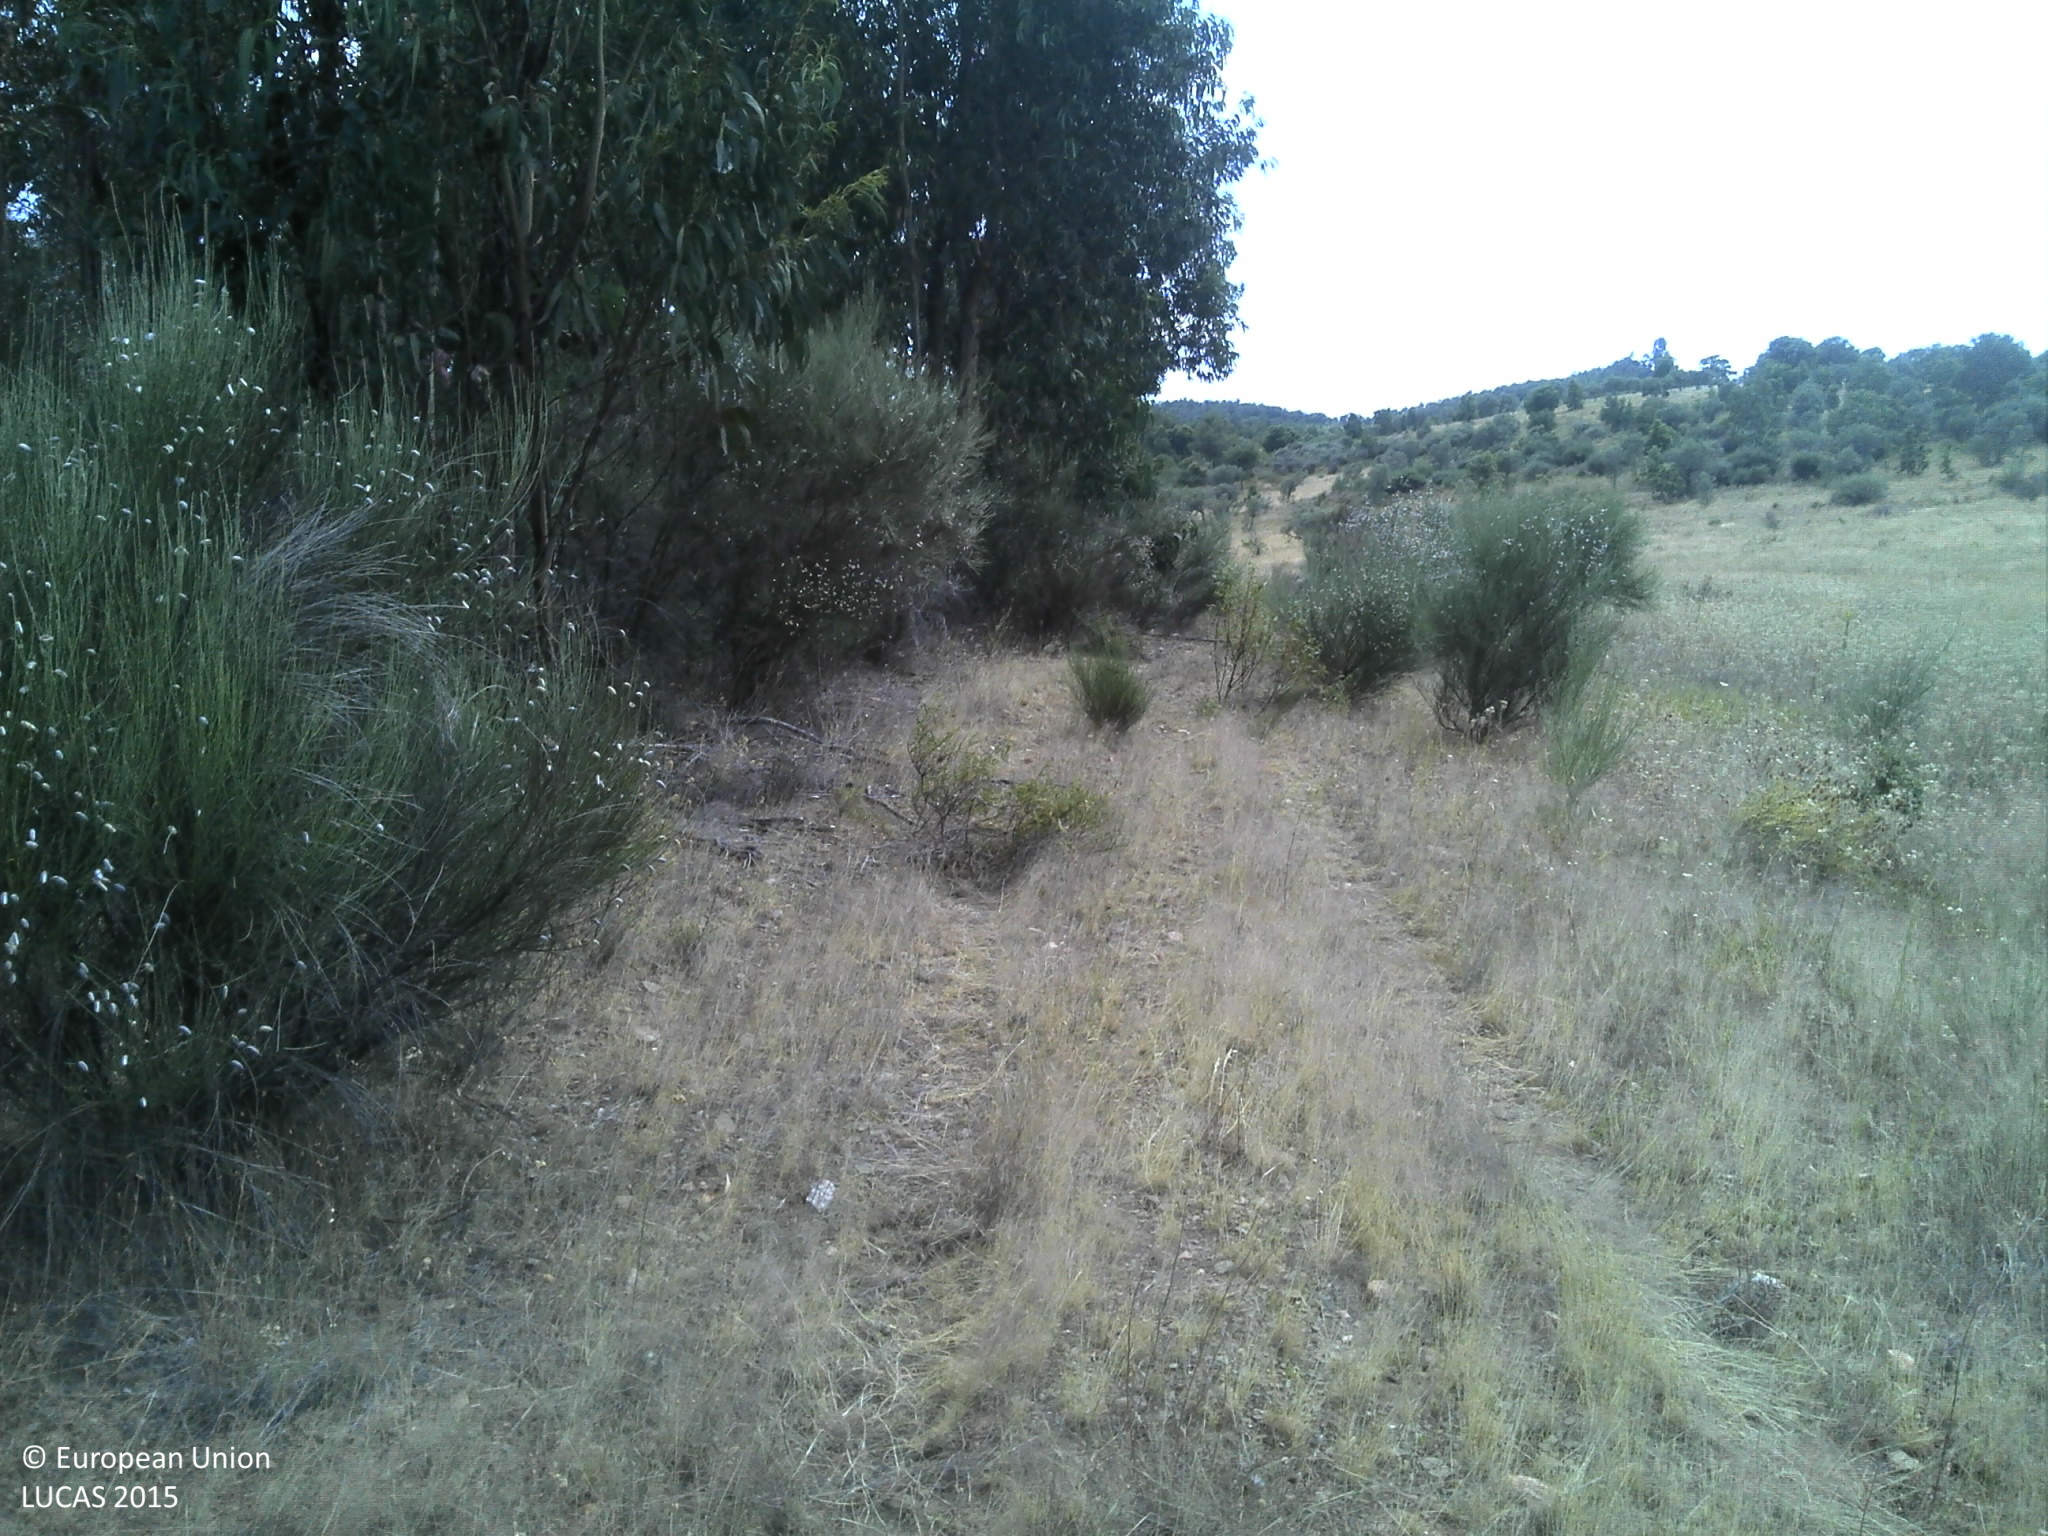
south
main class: Woodland
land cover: Broadleaved woodland
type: broadleaved evergreen forest
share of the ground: 50 - 75 %
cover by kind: broadleaved forest trees 65 %, shrubs 25 %, unconsolidated bare surface 5 %
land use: Forestry
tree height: > 5 m
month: June
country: PT
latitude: 40.1499
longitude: -7.1293
